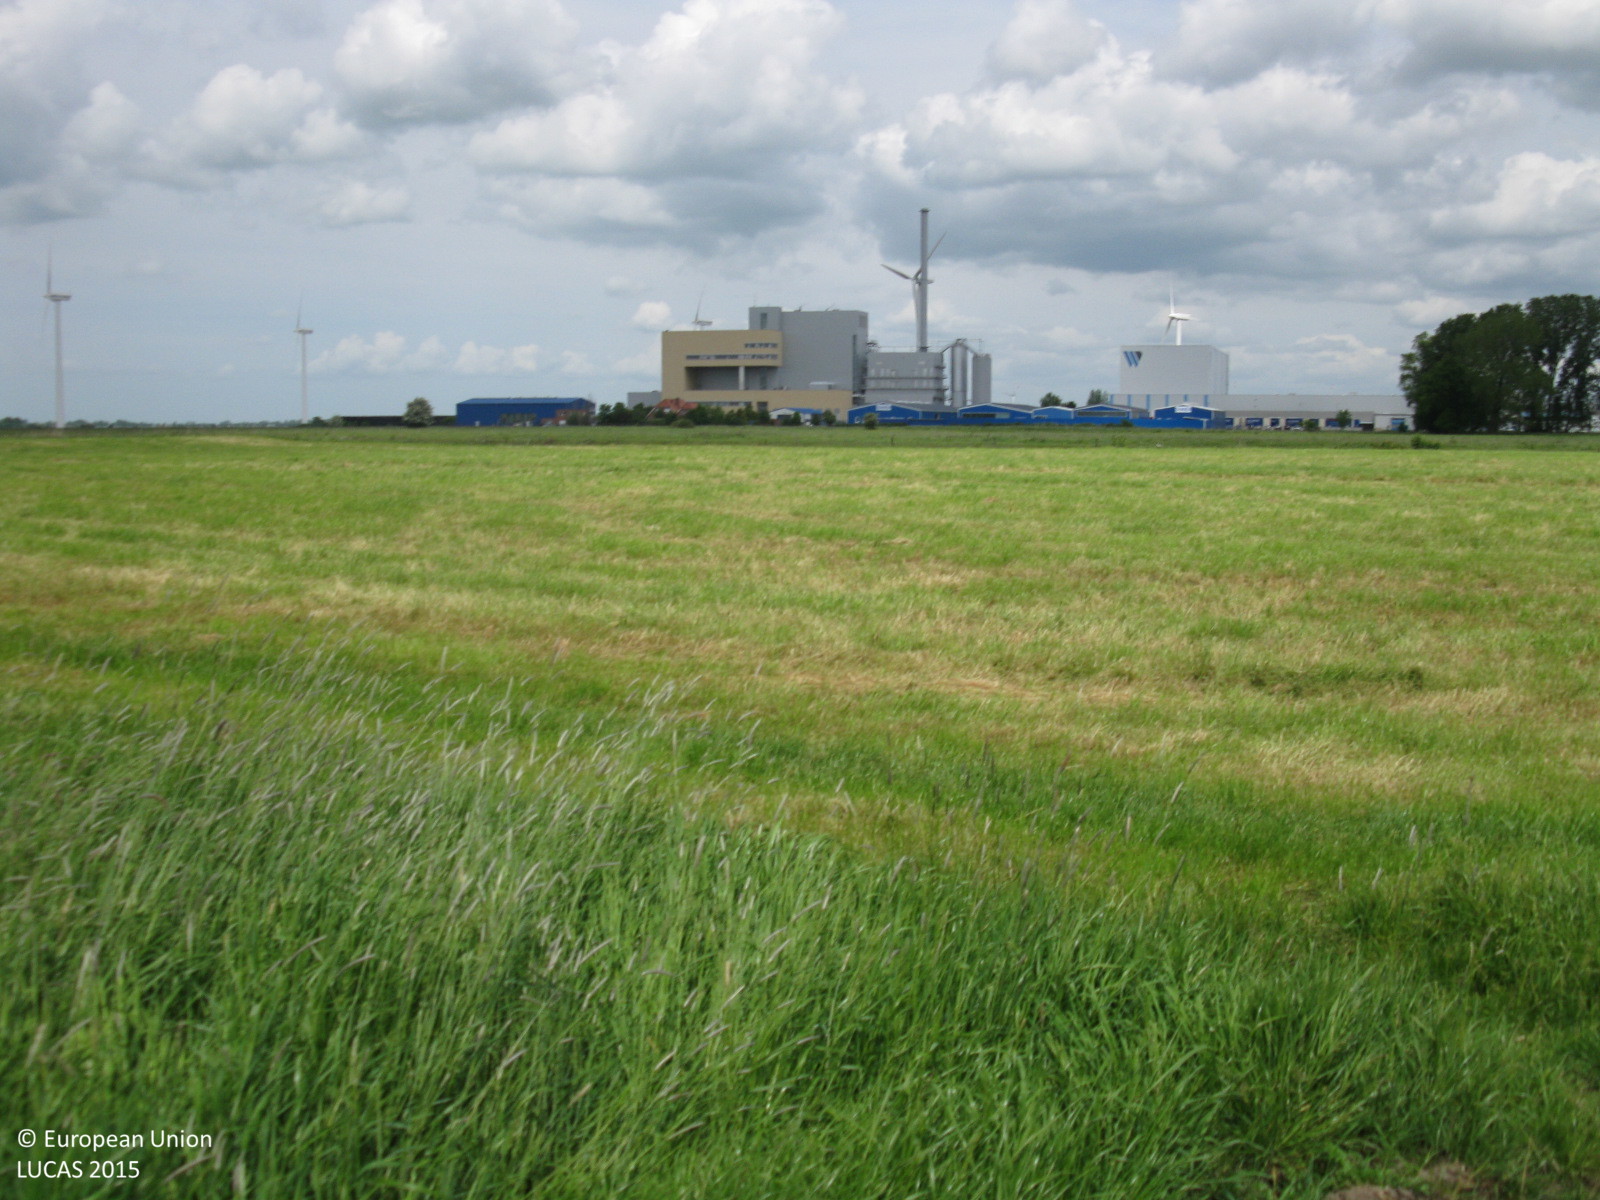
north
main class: Grassland
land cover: Grassland without tree/shrub cover
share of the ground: > 75 %
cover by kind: herbaceous plants 100 %
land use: Agriculture (excluding fallow land and kitchen gardens)
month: June
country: DE
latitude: 53.1752
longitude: 7.3524
